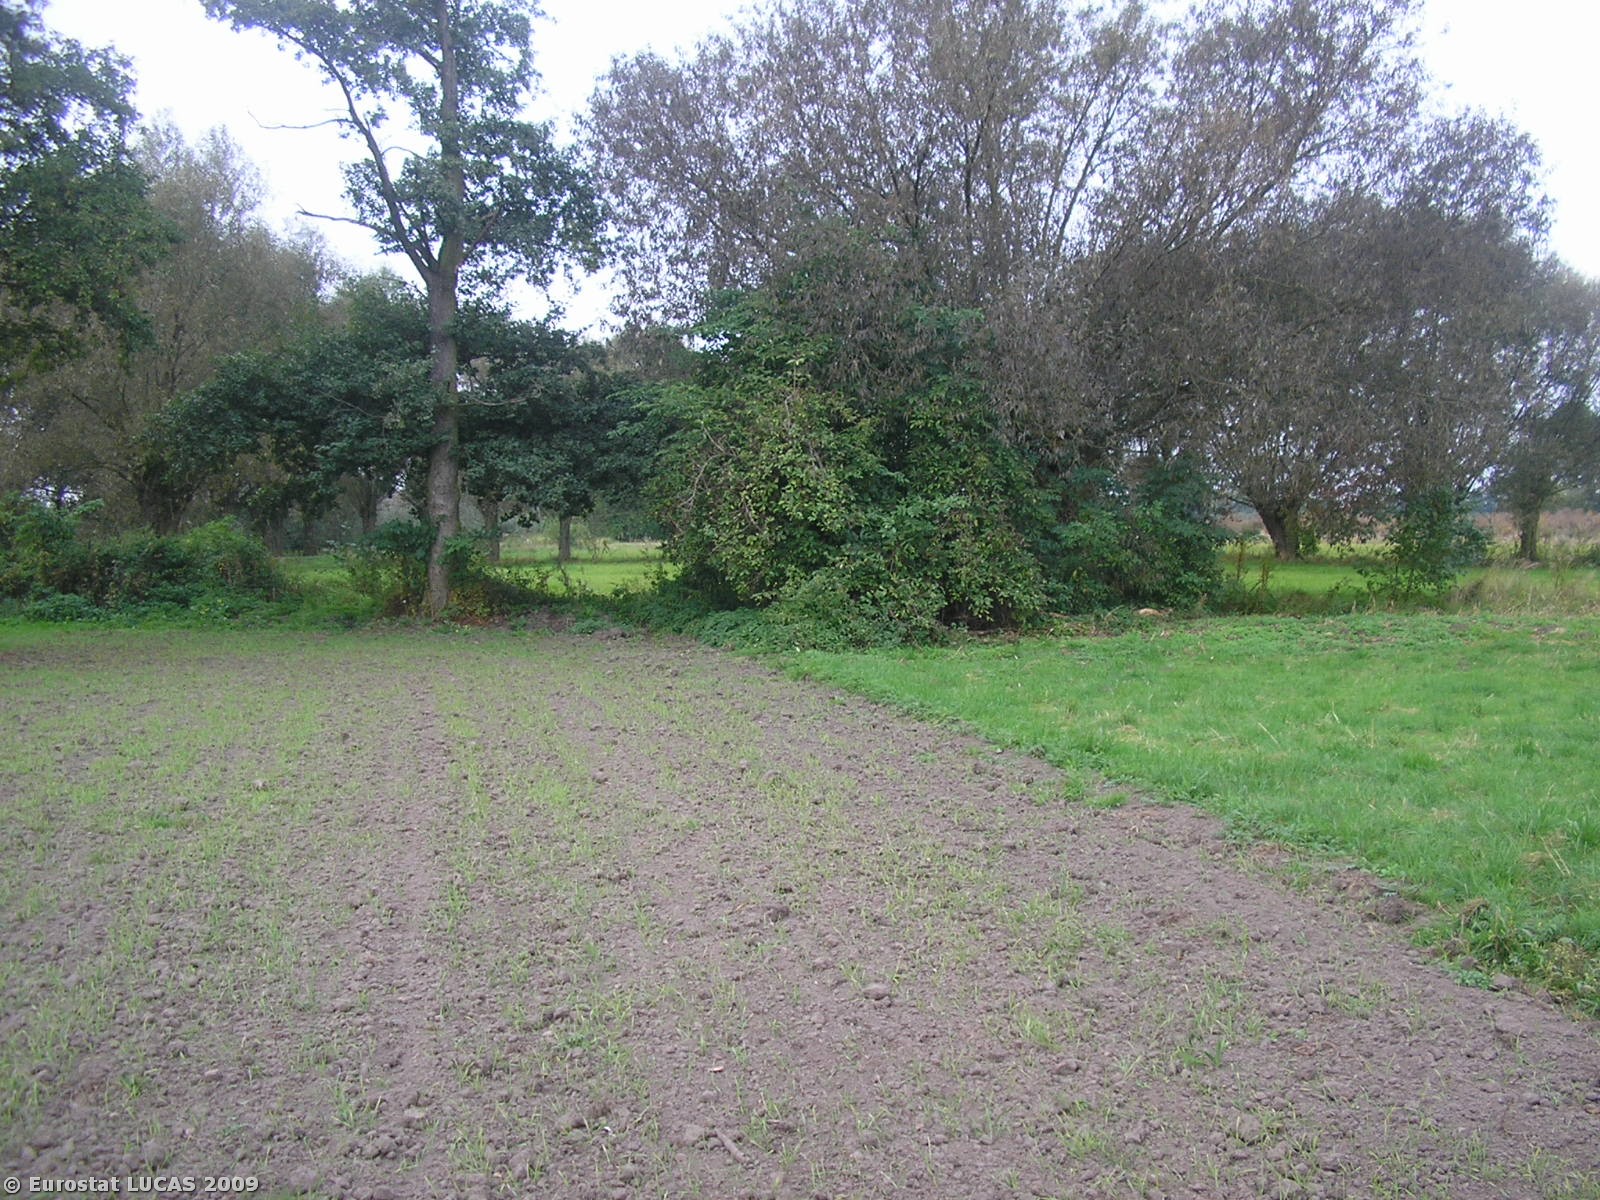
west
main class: Cropland
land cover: Triticale
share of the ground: < 10 %
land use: Agriculture (excluding fallow land and kitchen gardens)
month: September
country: PL
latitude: 51.7928
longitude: 20.9910
